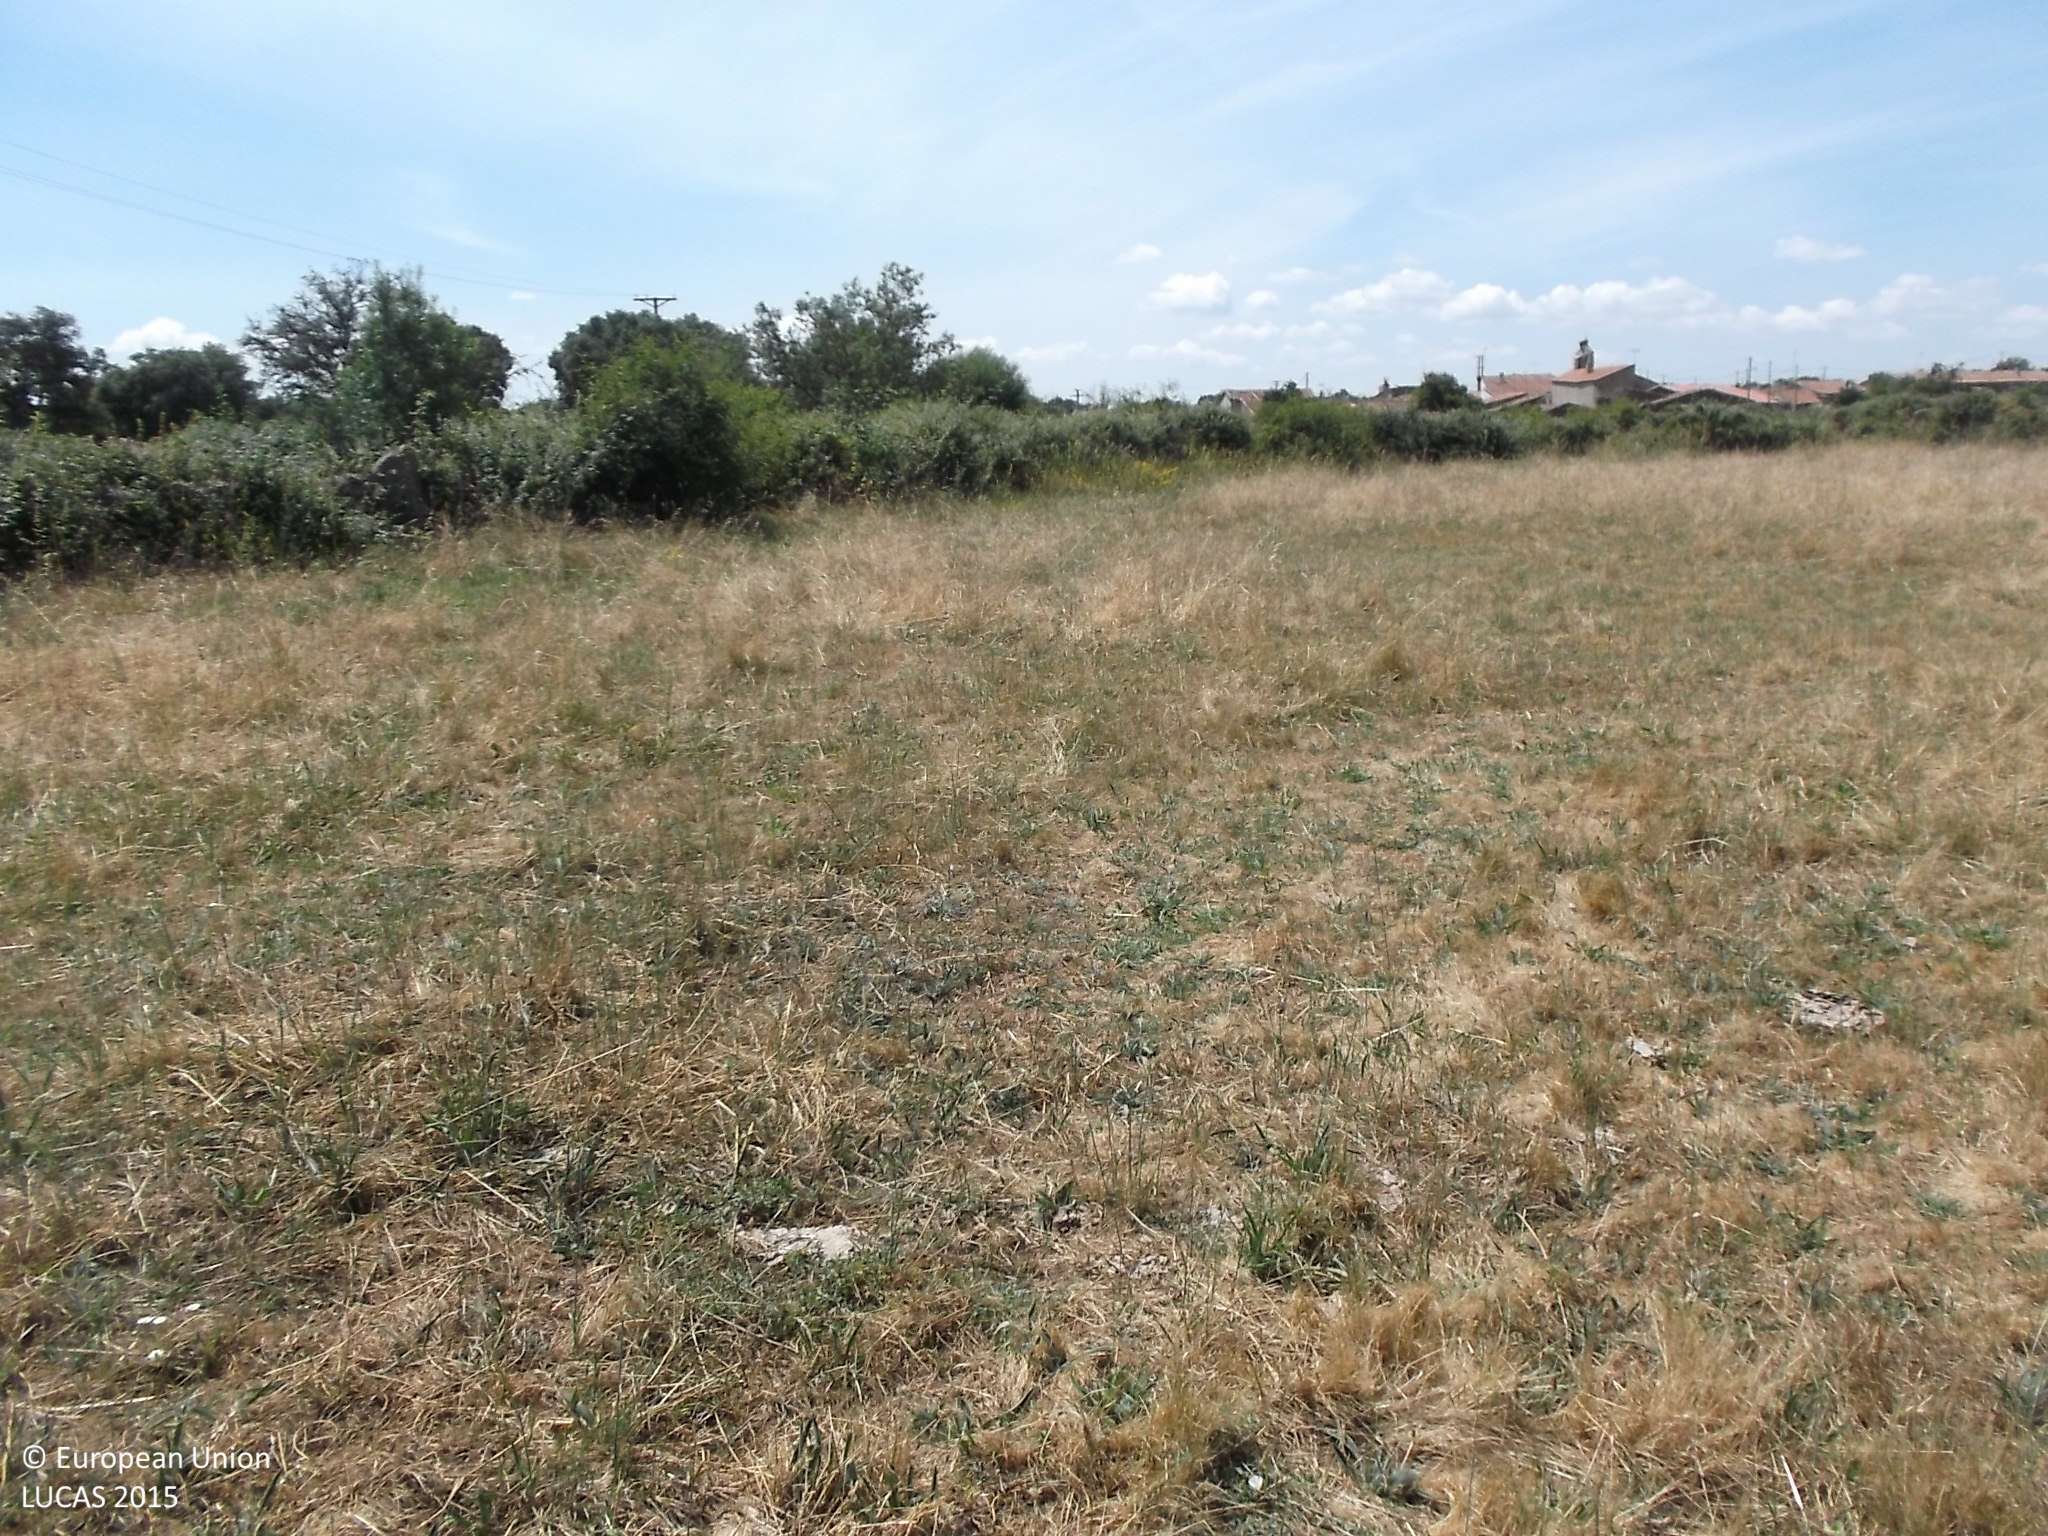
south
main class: Grassland
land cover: Grassland without tree/shrub cover
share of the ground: > 75 %
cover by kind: herbaceous plants 100 %
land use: Agriculture (excluding fallow land and kitchen gardens)
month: June
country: ES
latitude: 41.2624
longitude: -5.9989
